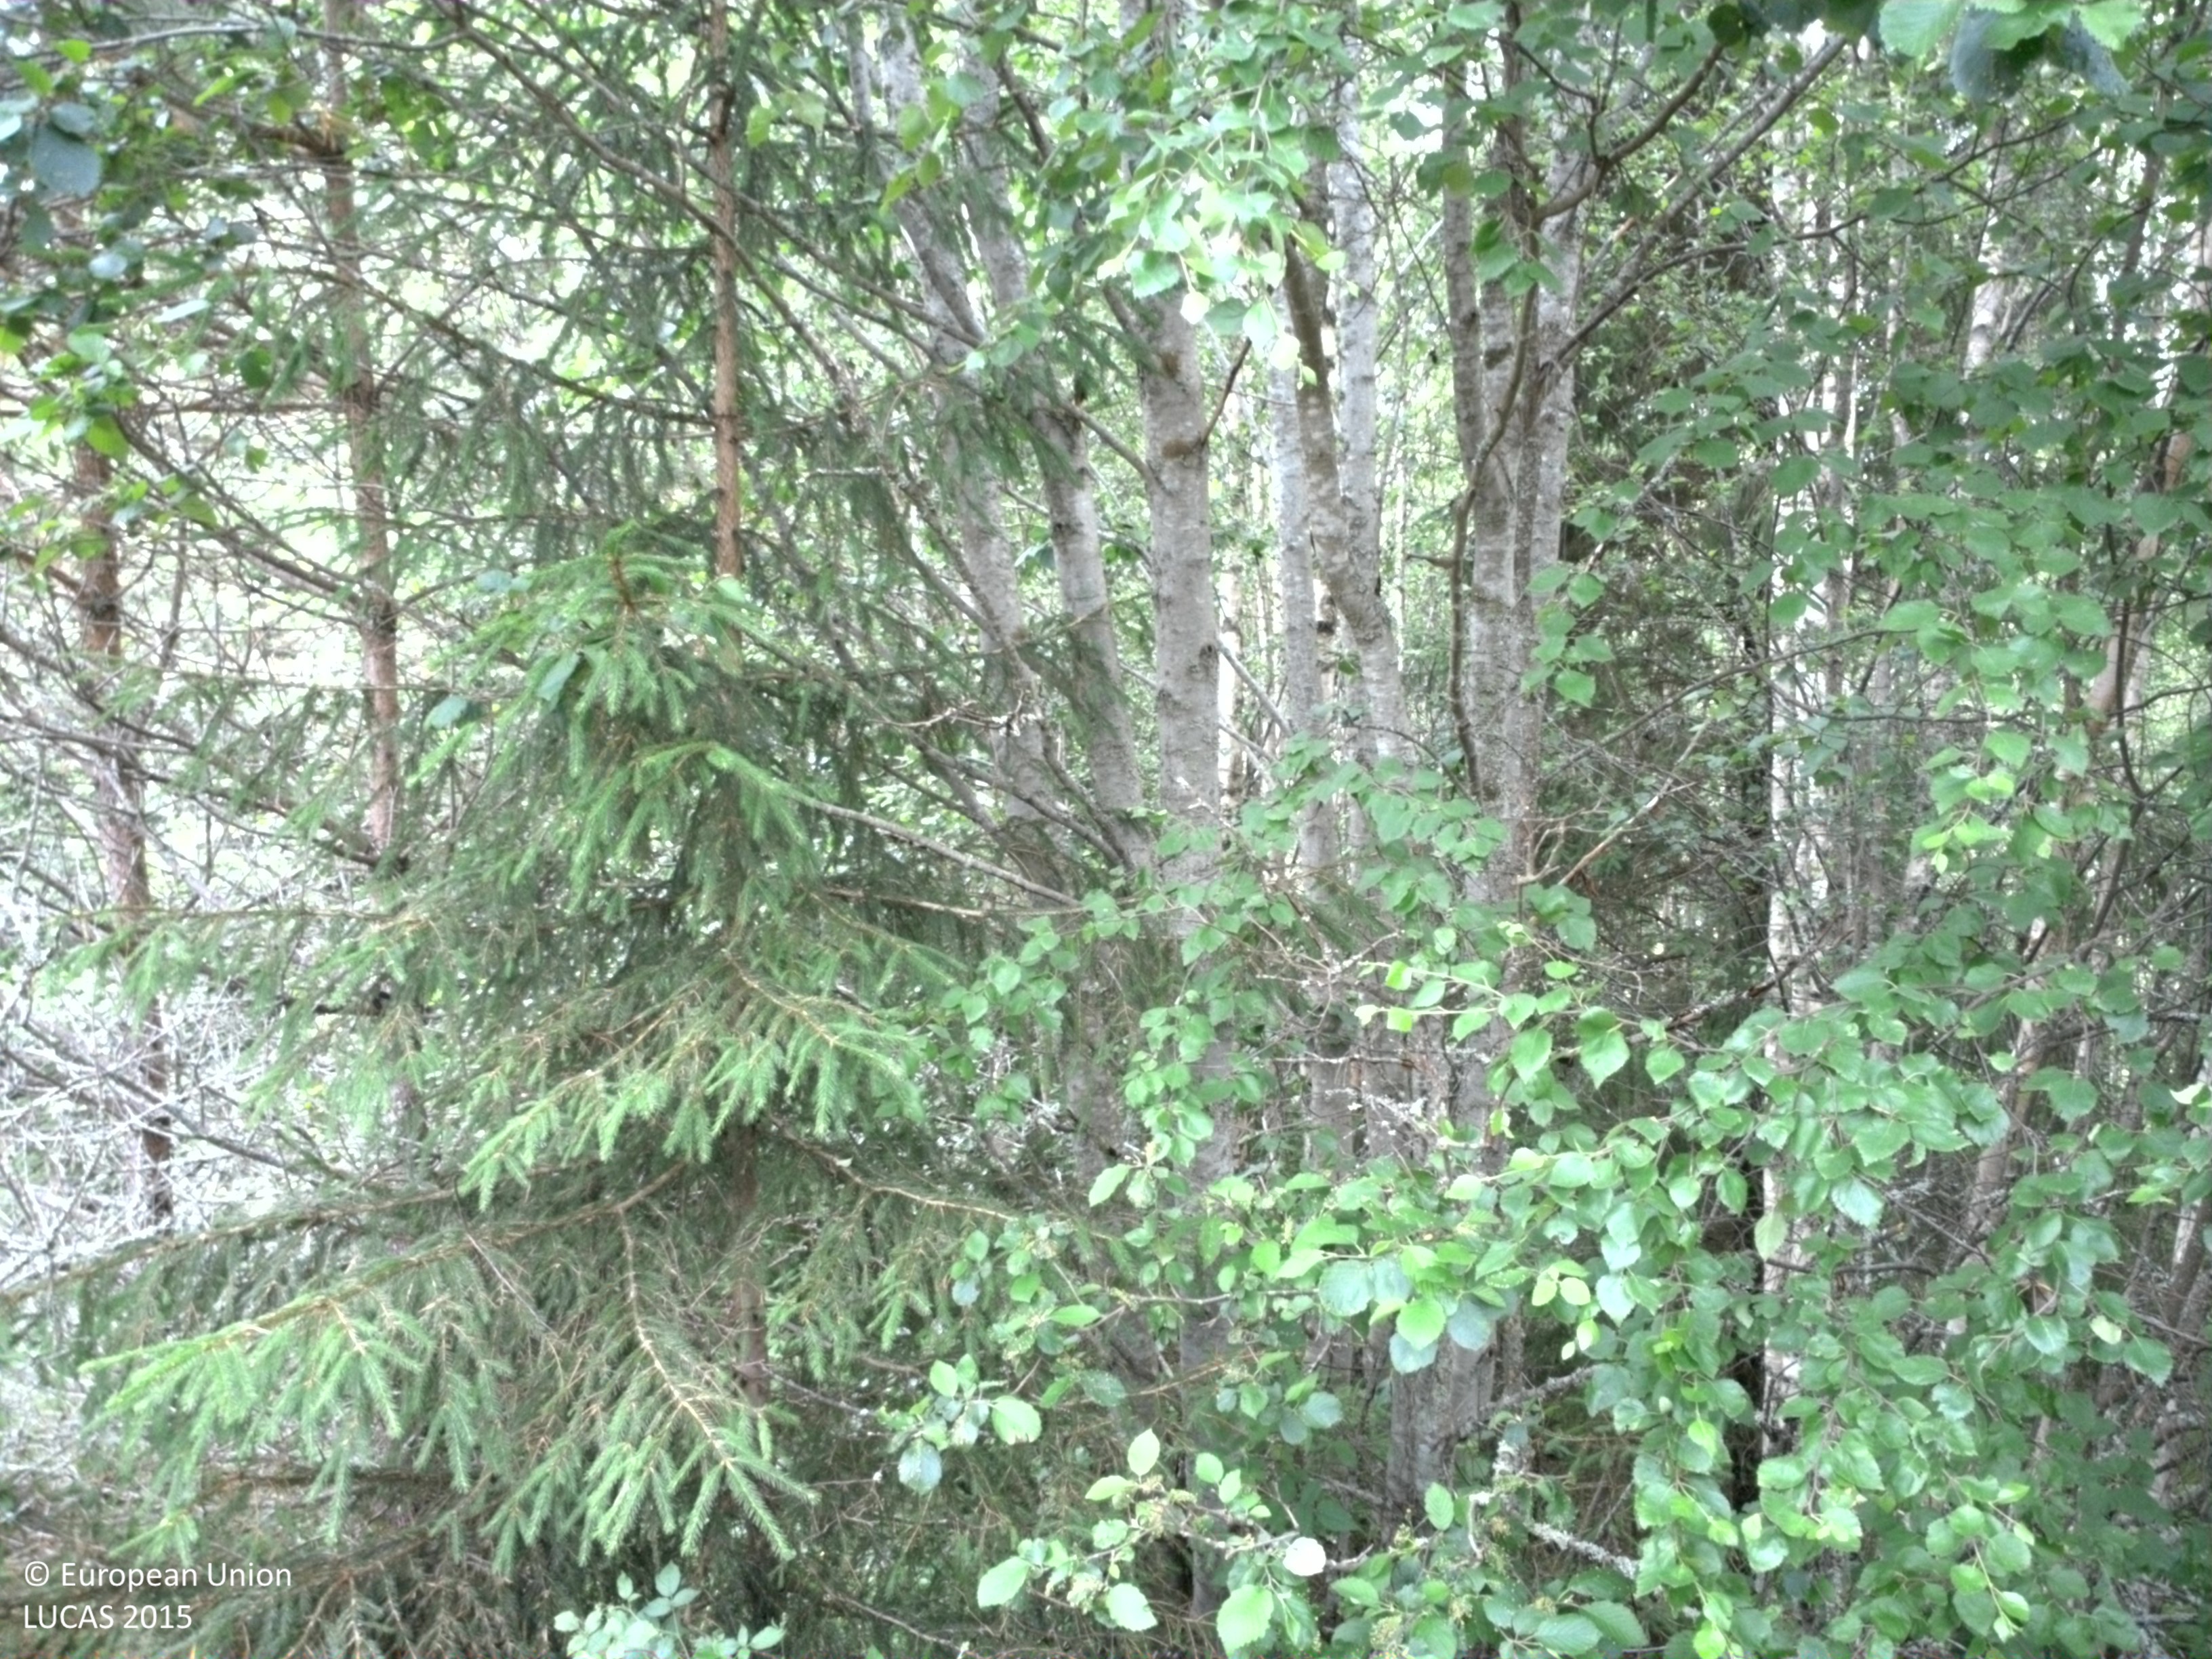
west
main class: Woodland
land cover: Pine dominated coniferous woodland
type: boreal forest
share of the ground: 10 - 25 %
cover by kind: consolidated bare surface 65 %, coniferous forest trees 20 %, broadleaved forest trees 5 %, shrubs 5 %, lichens and mosses 5 %
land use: Forestry
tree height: < 5 m
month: July
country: SE
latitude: 59.2959
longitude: 12.3996
